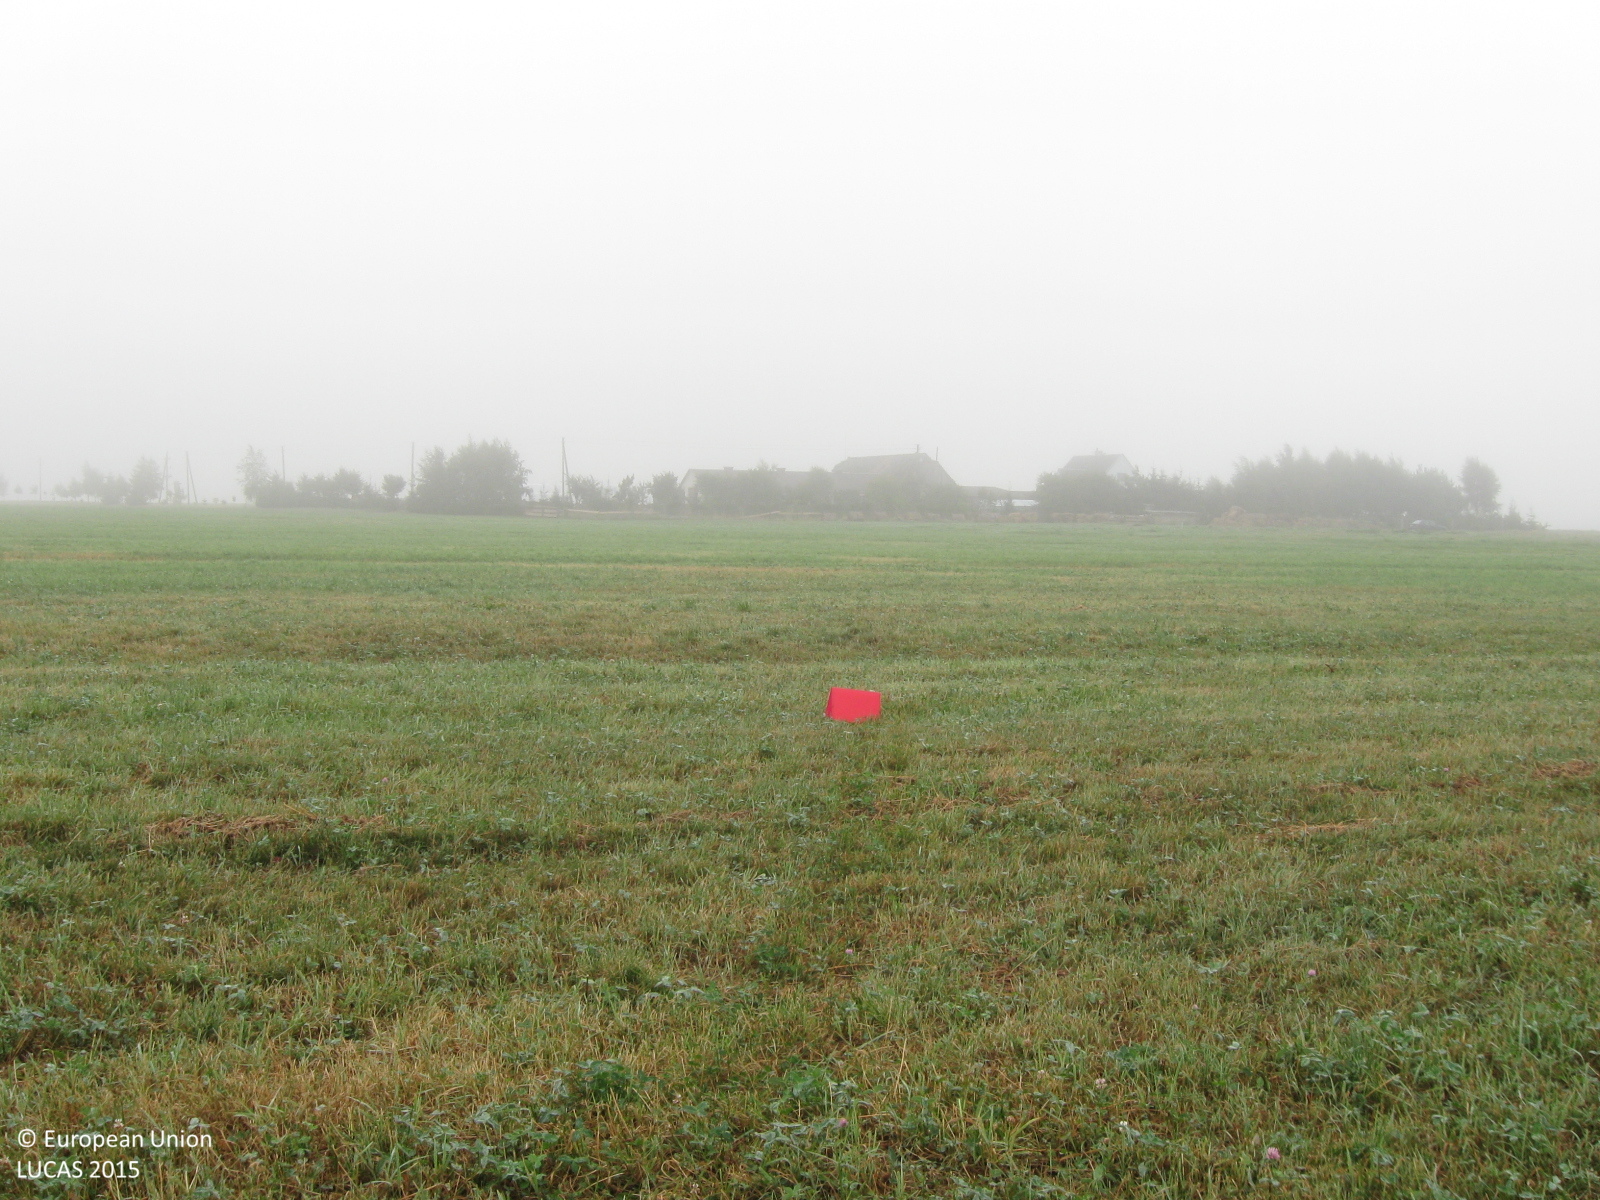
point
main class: Grassland
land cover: Grassland without tree/shrub cover
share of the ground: > 75 %
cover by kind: herbaceous plants 100 %
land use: Agriculture (excluding fallow land and kitchen gardens)
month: August
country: LT
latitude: 55.3050
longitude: 23.1639
